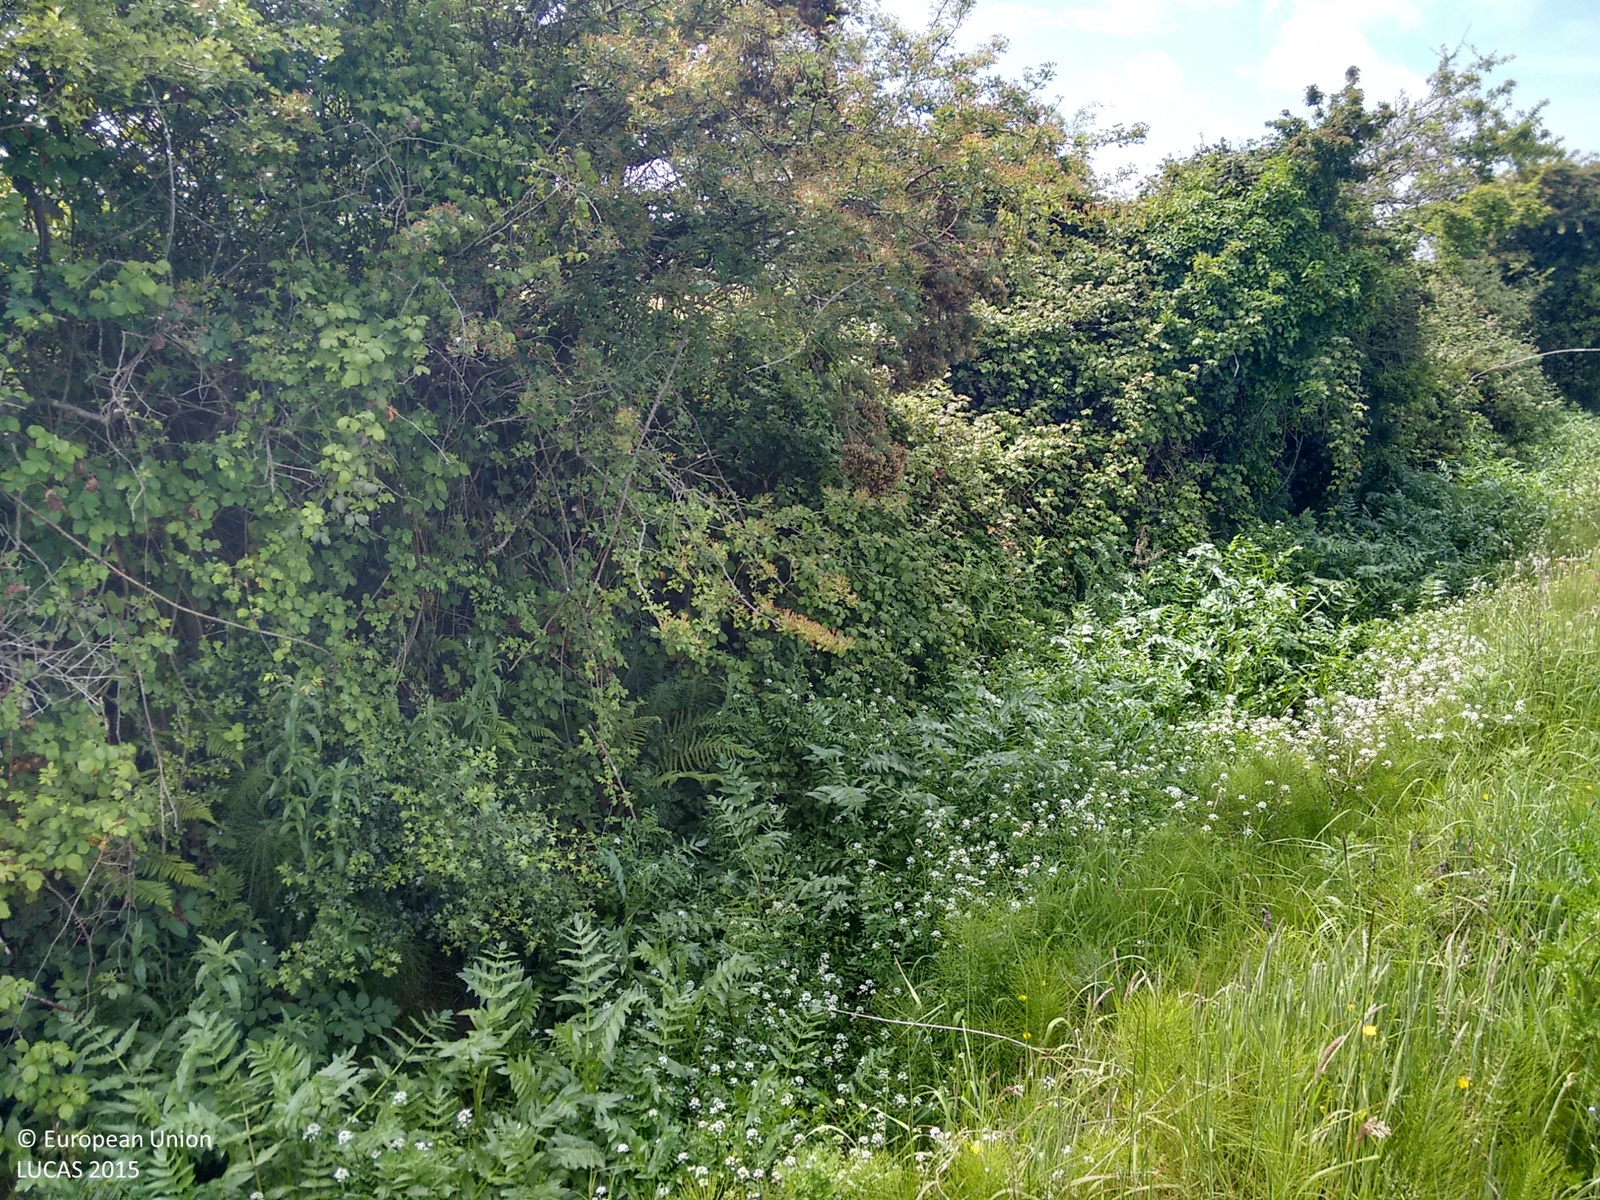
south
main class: Cropland
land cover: Rape and turnip rape
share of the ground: > 75 %
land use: Agriculture (excluding fallow land and kitchen gardens)
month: June
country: IE
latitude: 51.8573
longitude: -8.0816
